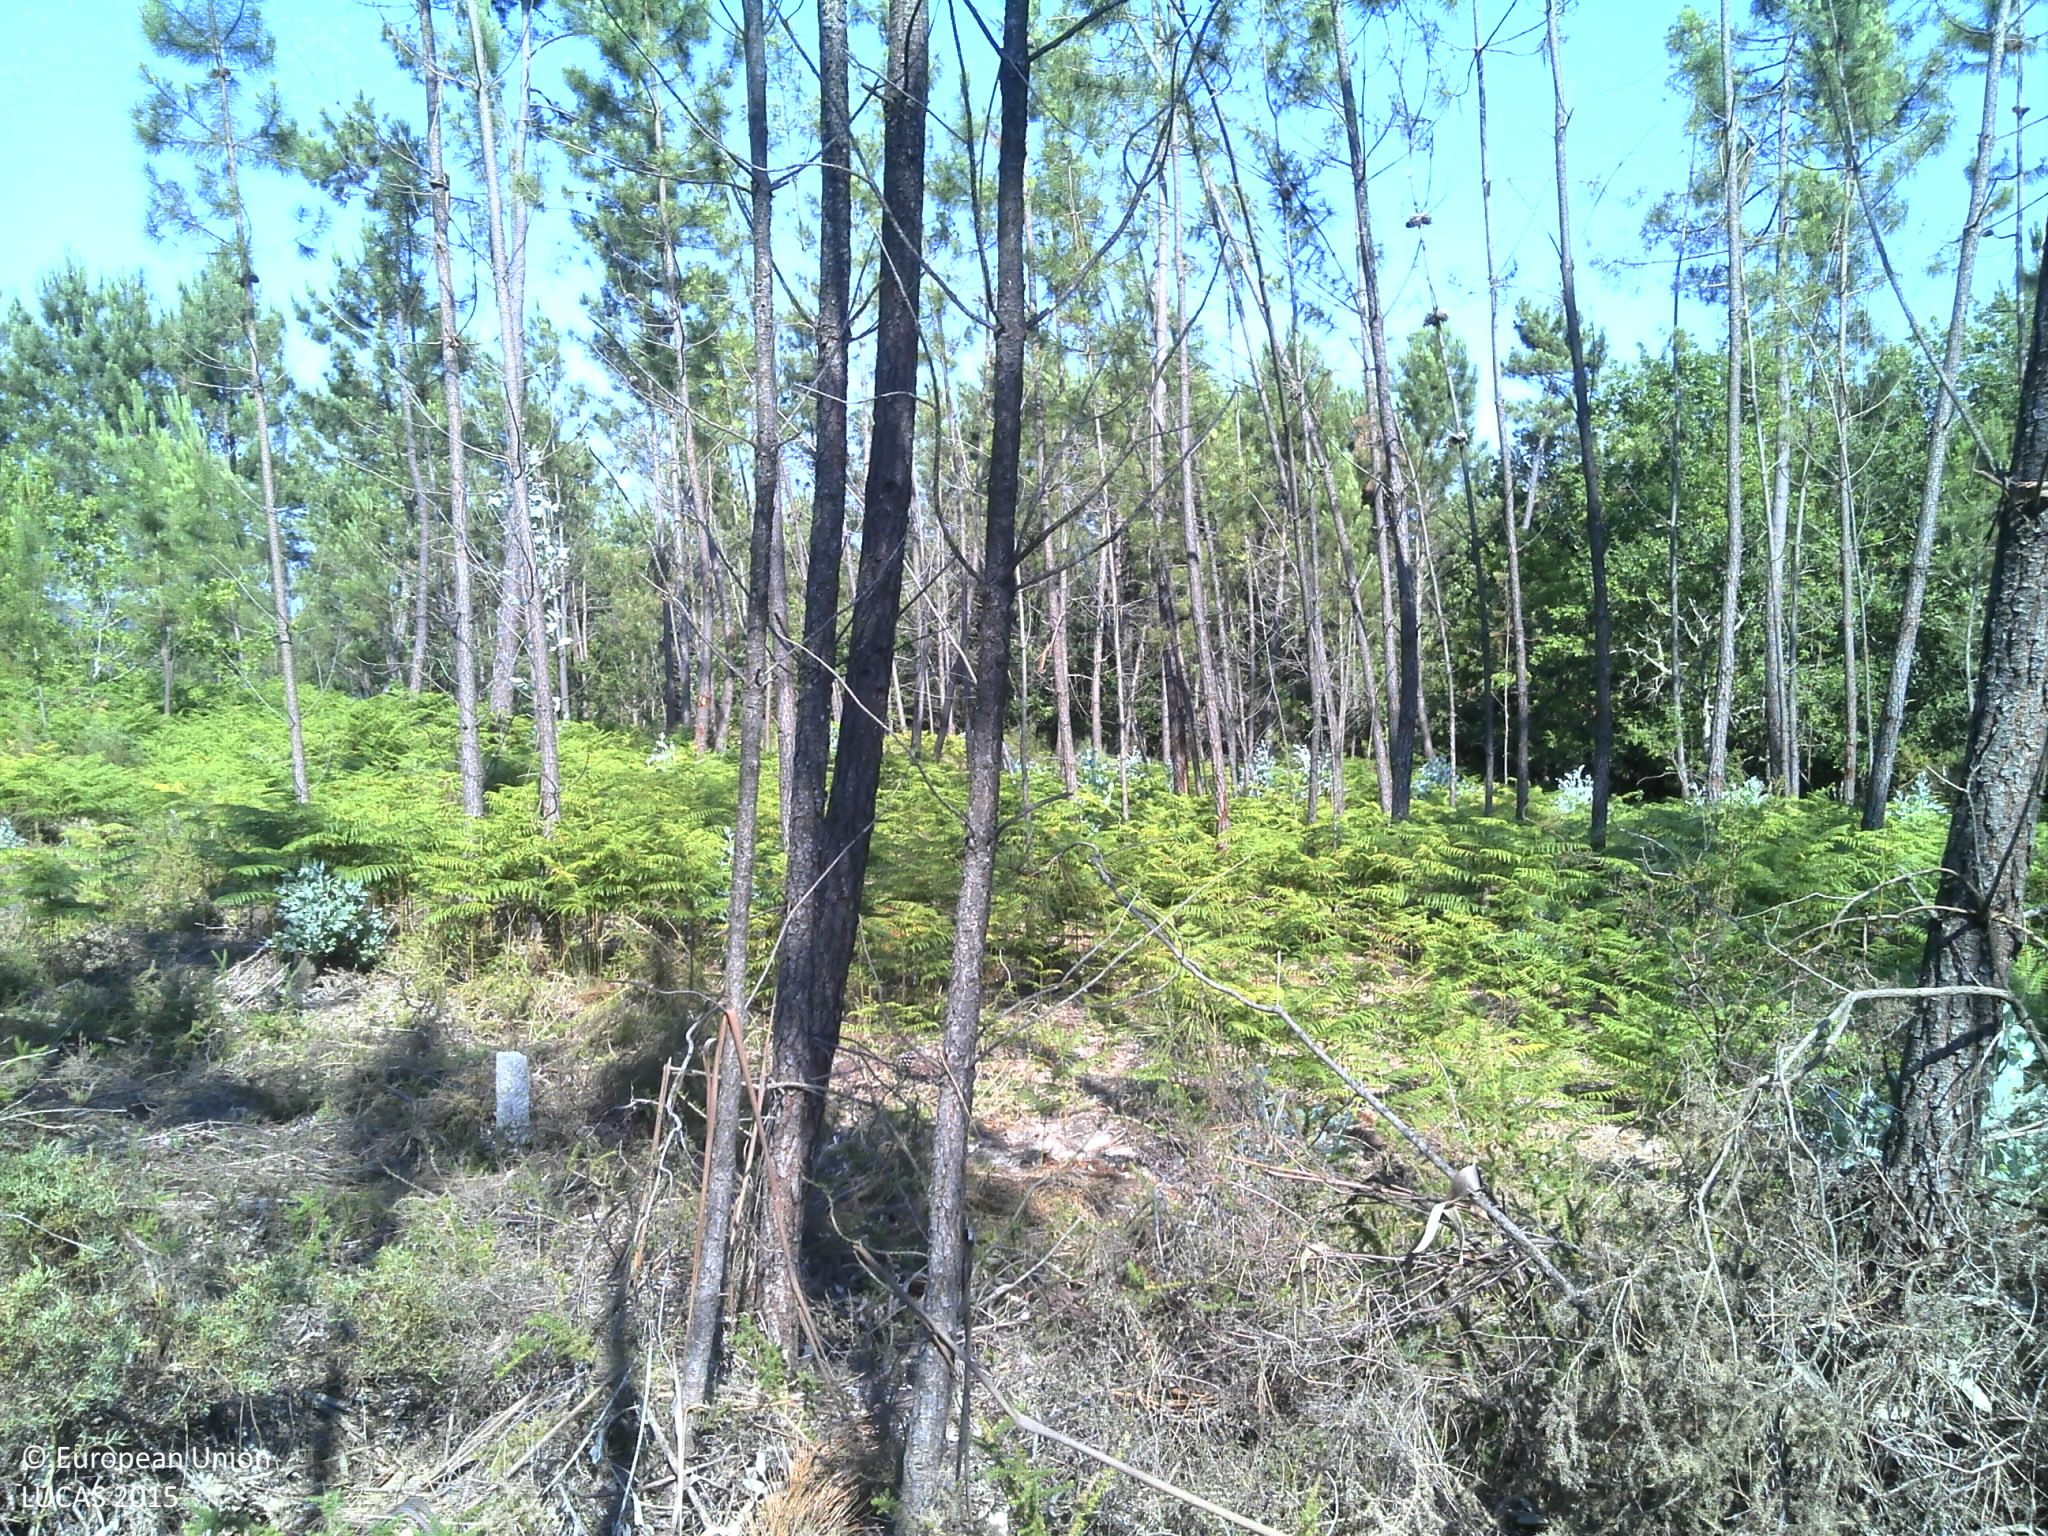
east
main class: Woodland
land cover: Pine dominated coniferous woodland
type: coniferous forest of the mediterranean region
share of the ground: 25 - 50 %
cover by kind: coniferous forest trees 45 %, shrubs 40 %, unconsolidated bare surface 10 %, herbaceous plants 5 %
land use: Forestry
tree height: > 5 m
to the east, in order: Pine dominated coniferous woodland; Shrubland with sparse tree cover; Pine dominated coniferous woodland; Other mixed woodland; Broadleaved woodland; Shrubland with sparse tree cover; Broadleaved woodland
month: June
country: PT
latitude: 40.6307
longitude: -8.0388
